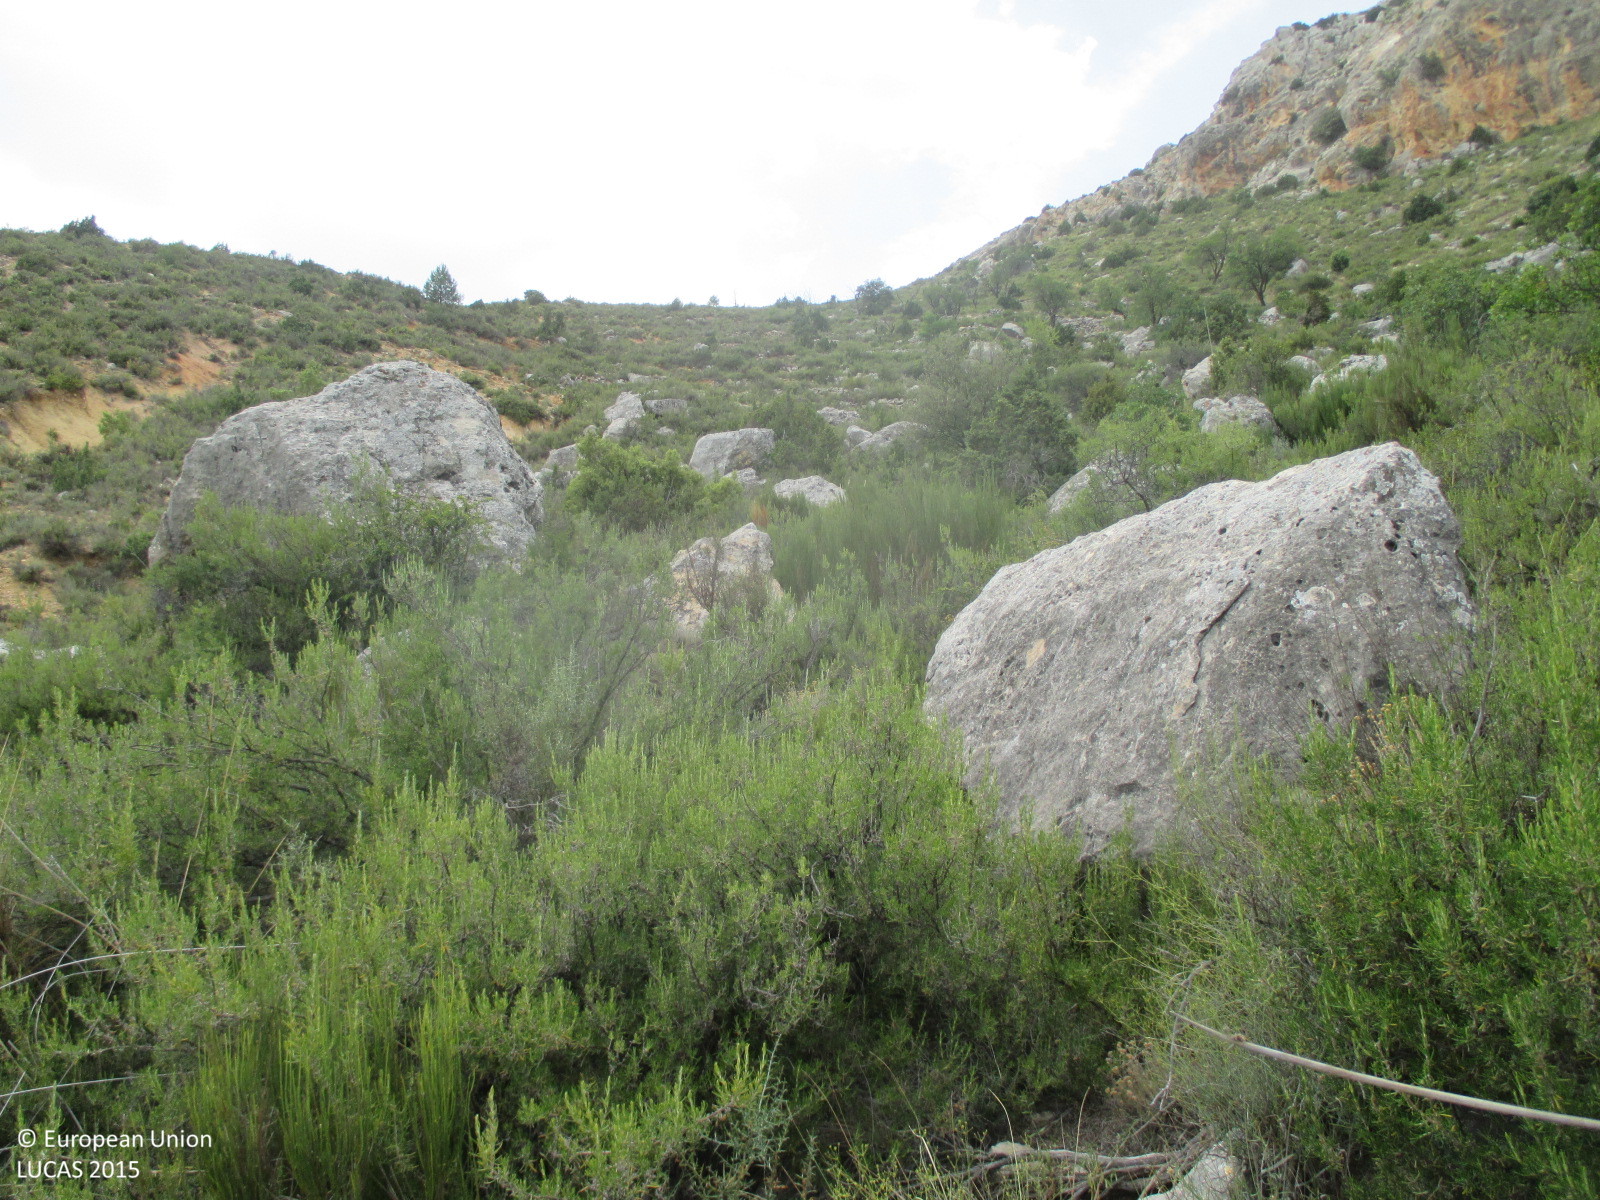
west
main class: Shrubland
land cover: Shrubland with sparse tree cover
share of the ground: > 75 %
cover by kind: shrubs 95 %, broadleaved forest trees 5 %
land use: Semi-natural and natural areas not in use
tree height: > 5 m
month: July
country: ES
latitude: 38.1480
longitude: -2.3512
